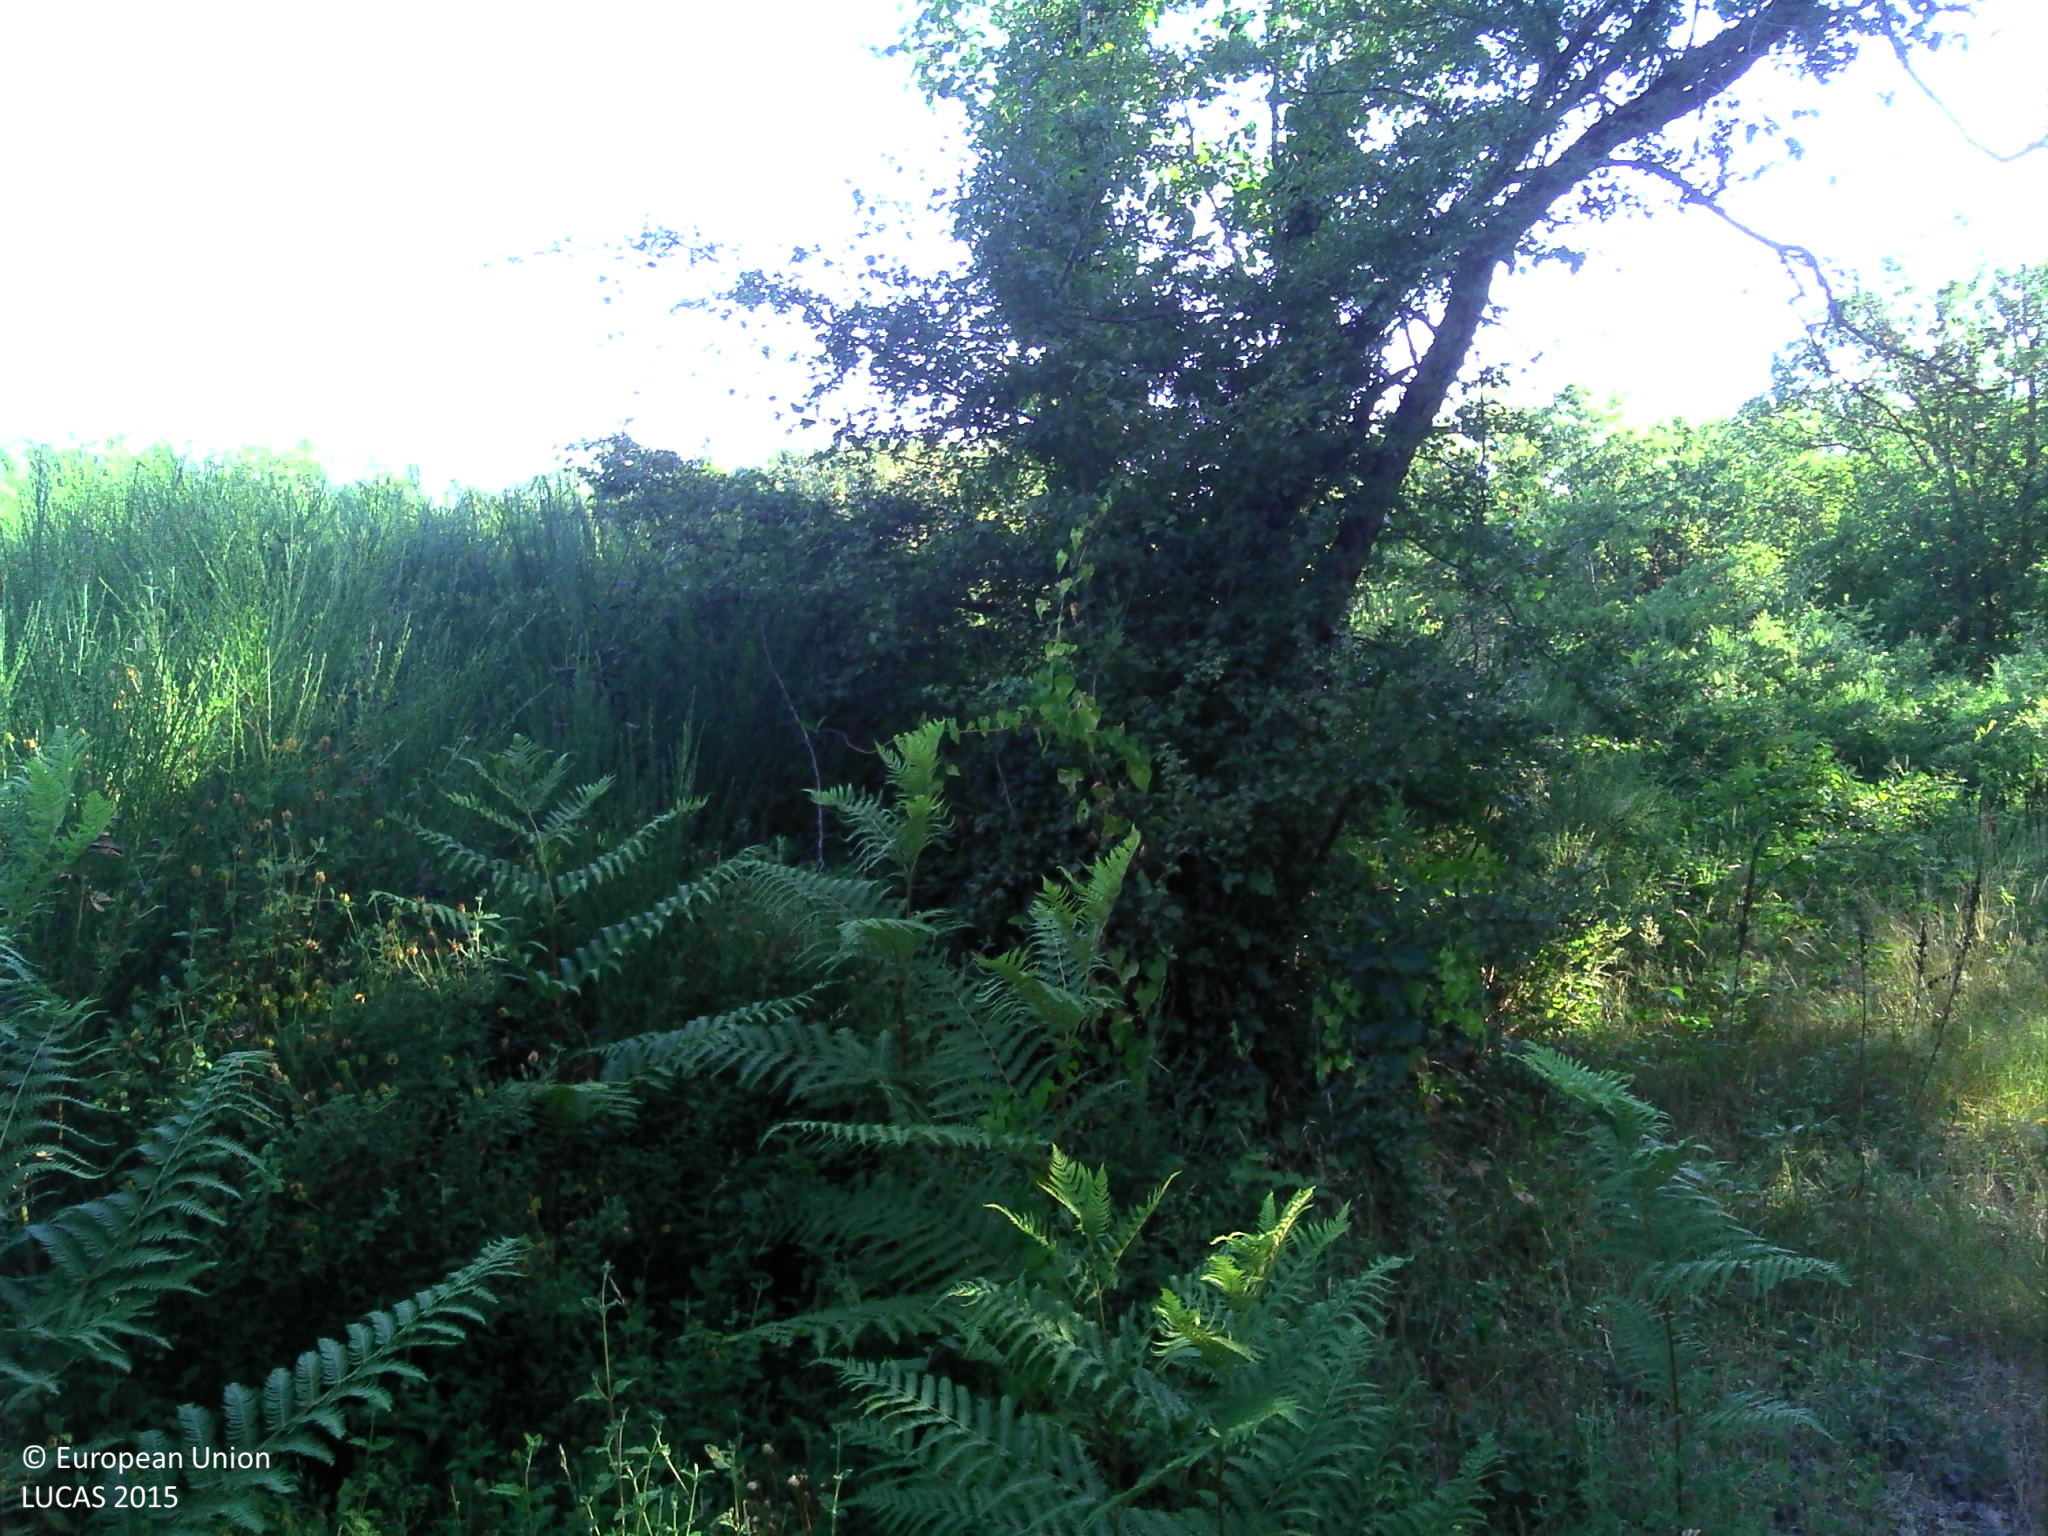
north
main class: Grassland
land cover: Spontaneously vegetated surfaces
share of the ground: > 75 %
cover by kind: herbaceous plants 60 %, lichens and mosses 15 %, shrubs 5 %
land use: Forestry
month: June
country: FR
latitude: 43.7711
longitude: 1.5669
